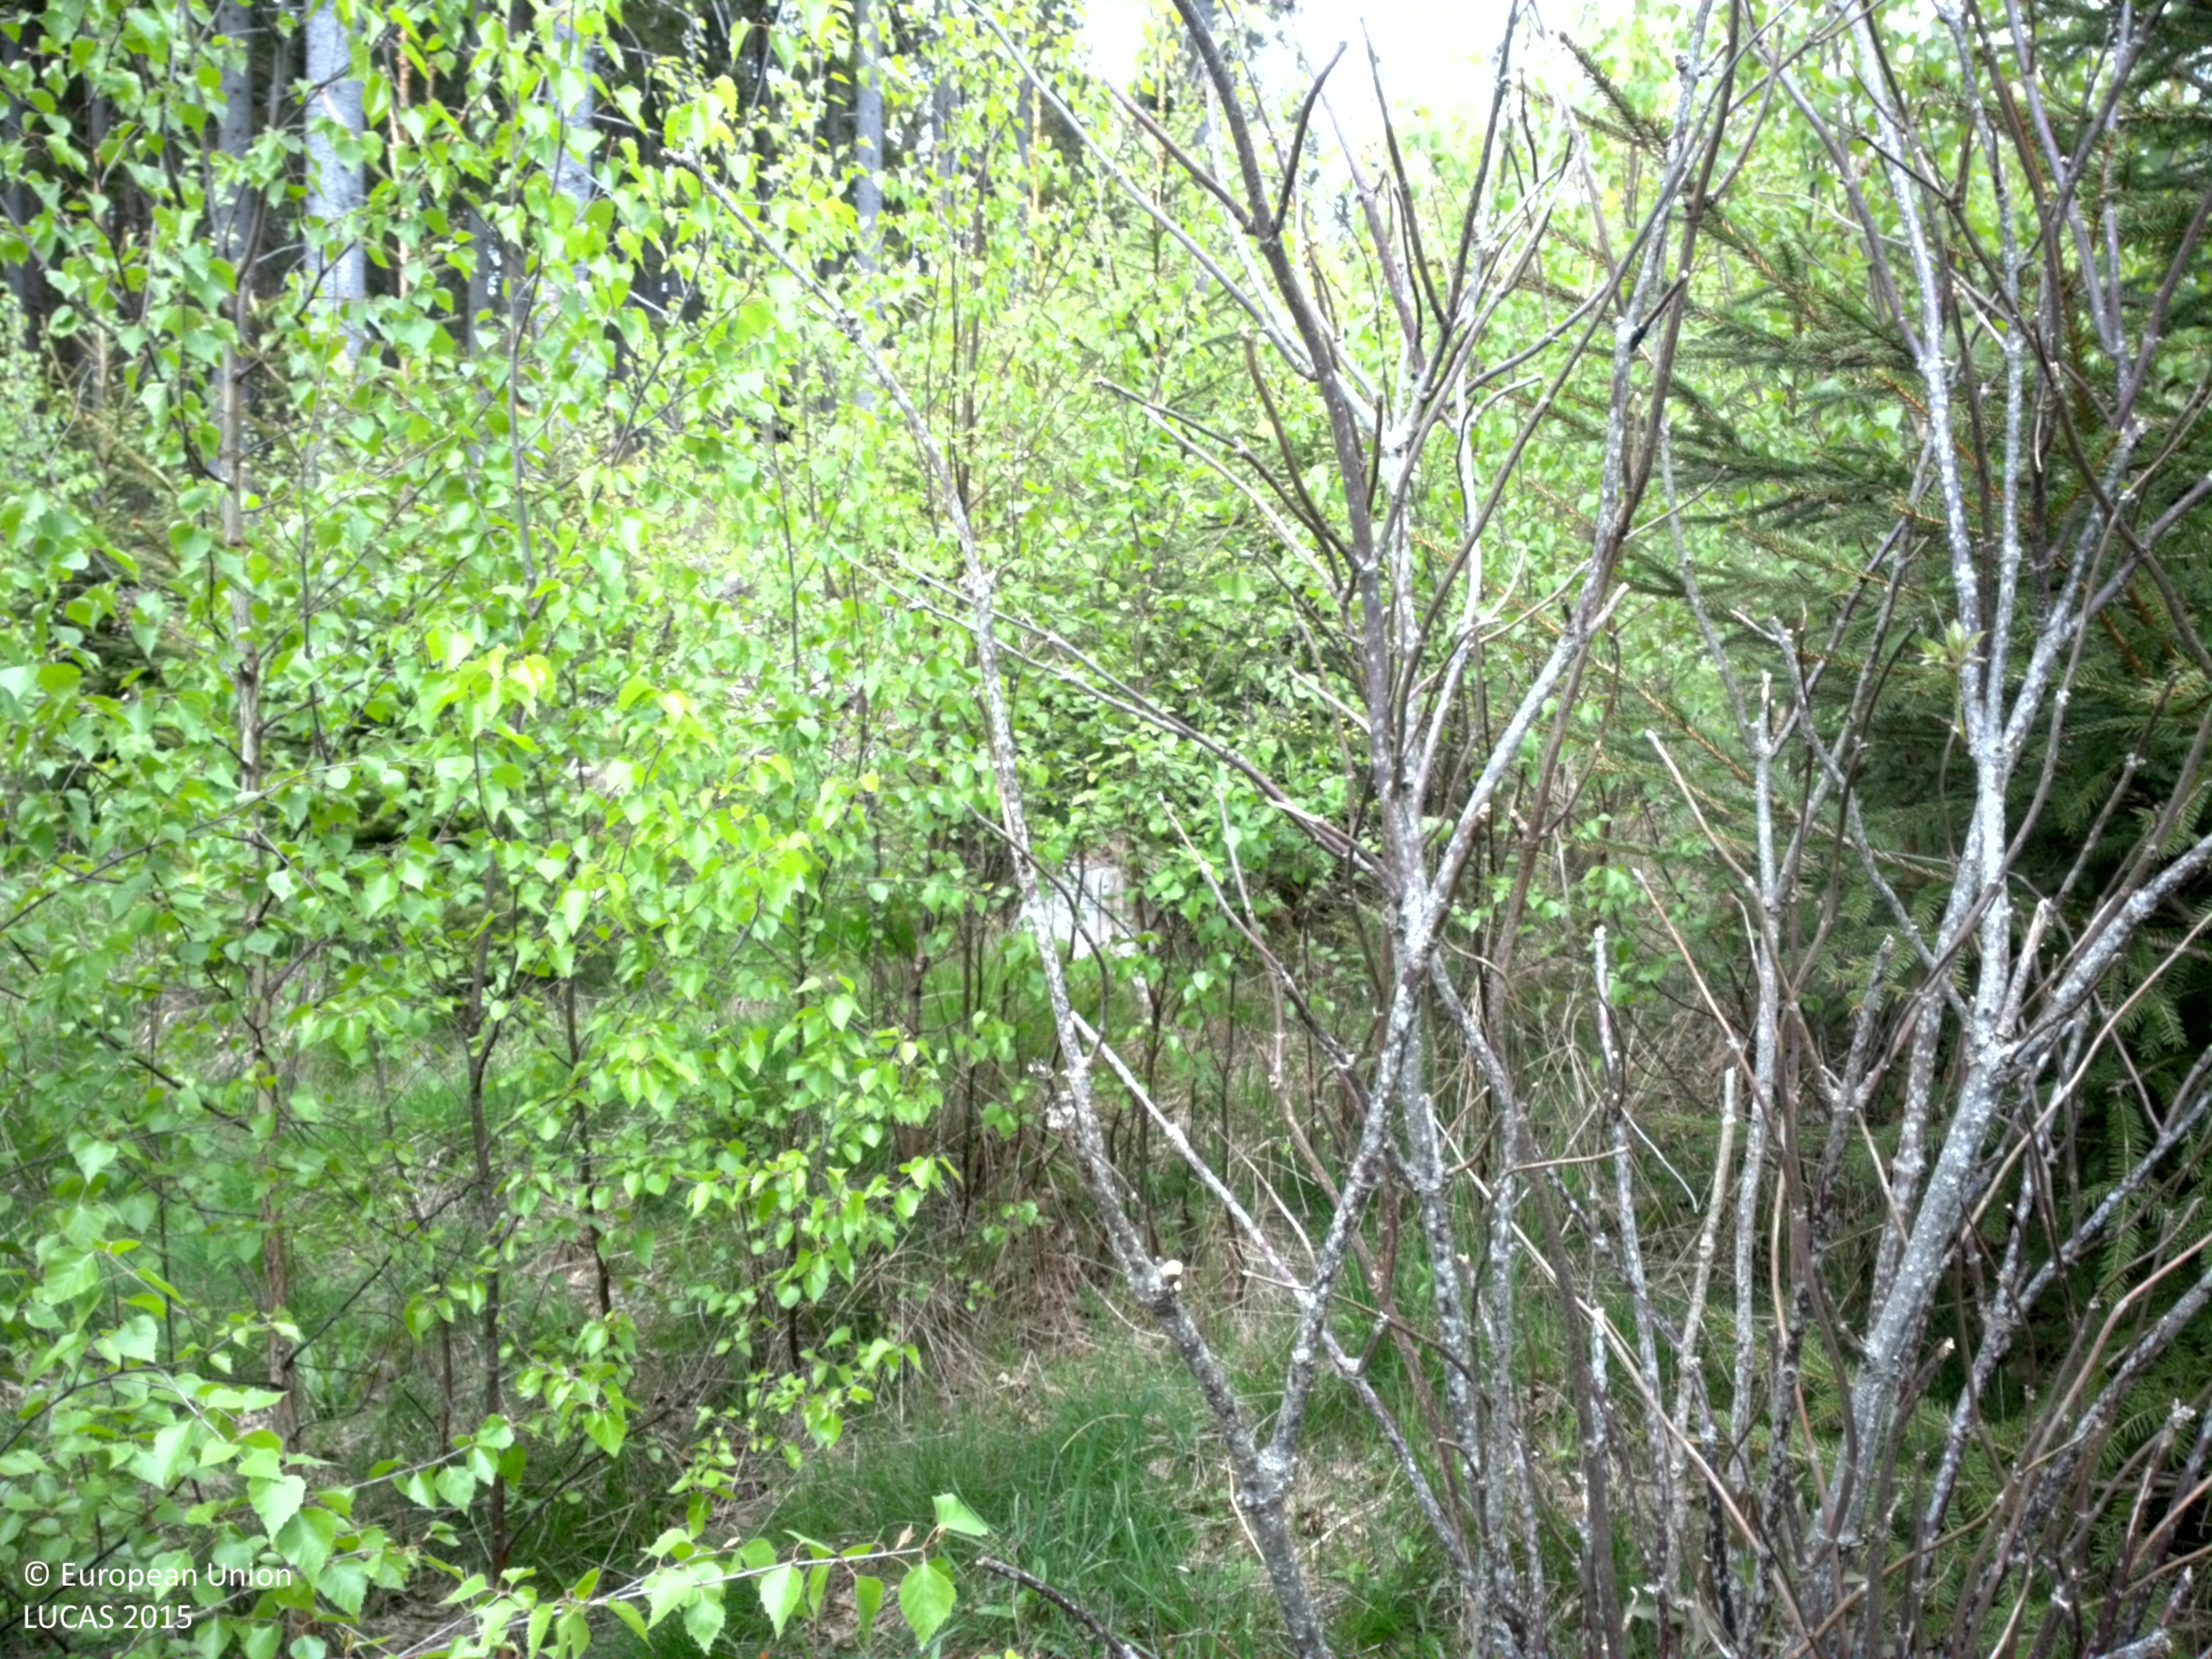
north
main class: Woodland
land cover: Broadleaved woodland
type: boreal forest
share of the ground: > 75 %
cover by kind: broadleaved forest trees 85 %, herbaceous plants 10 %, coniferous forest trees 5 %
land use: Forestry
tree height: < 5 m
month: May
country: SE
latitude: 56.7392
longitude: 15.4424
